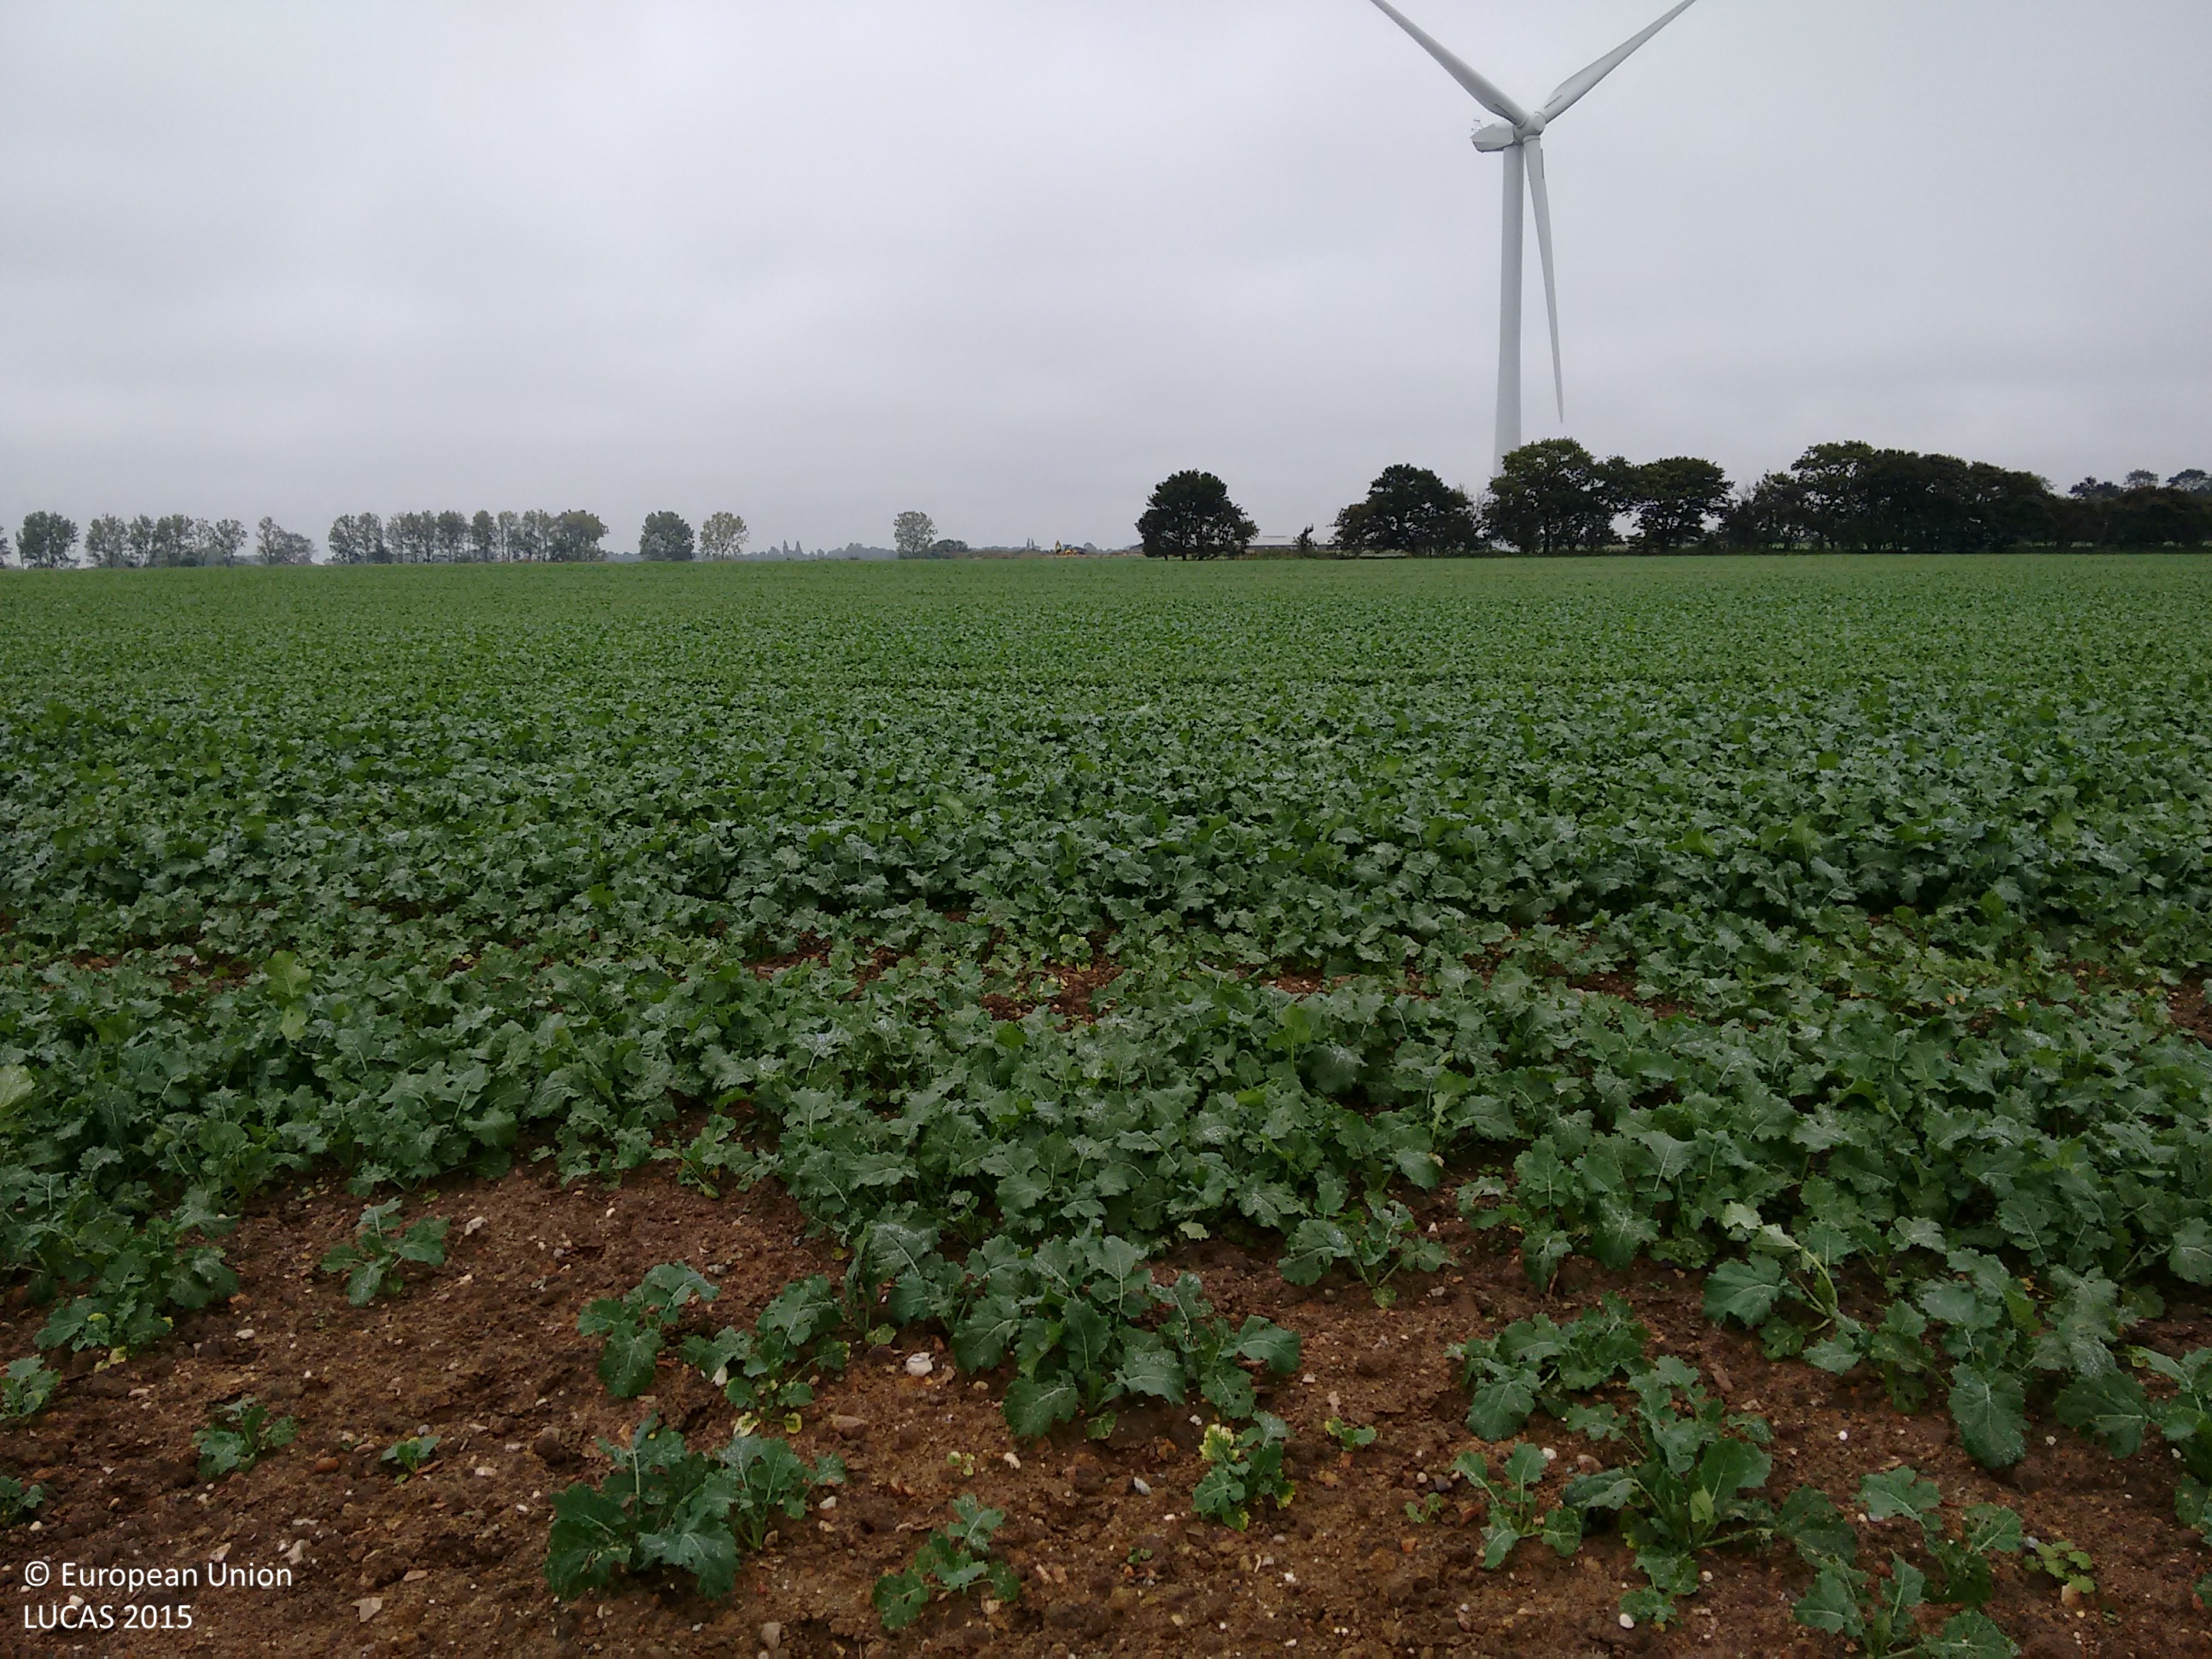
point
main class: Cropland
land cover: Rape and turnip rape
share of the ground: > 75 %
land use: Agriculture (excluding fallow land and kitchen gardens)
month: October
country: GB
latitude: 52.3642
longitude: 1.5370
